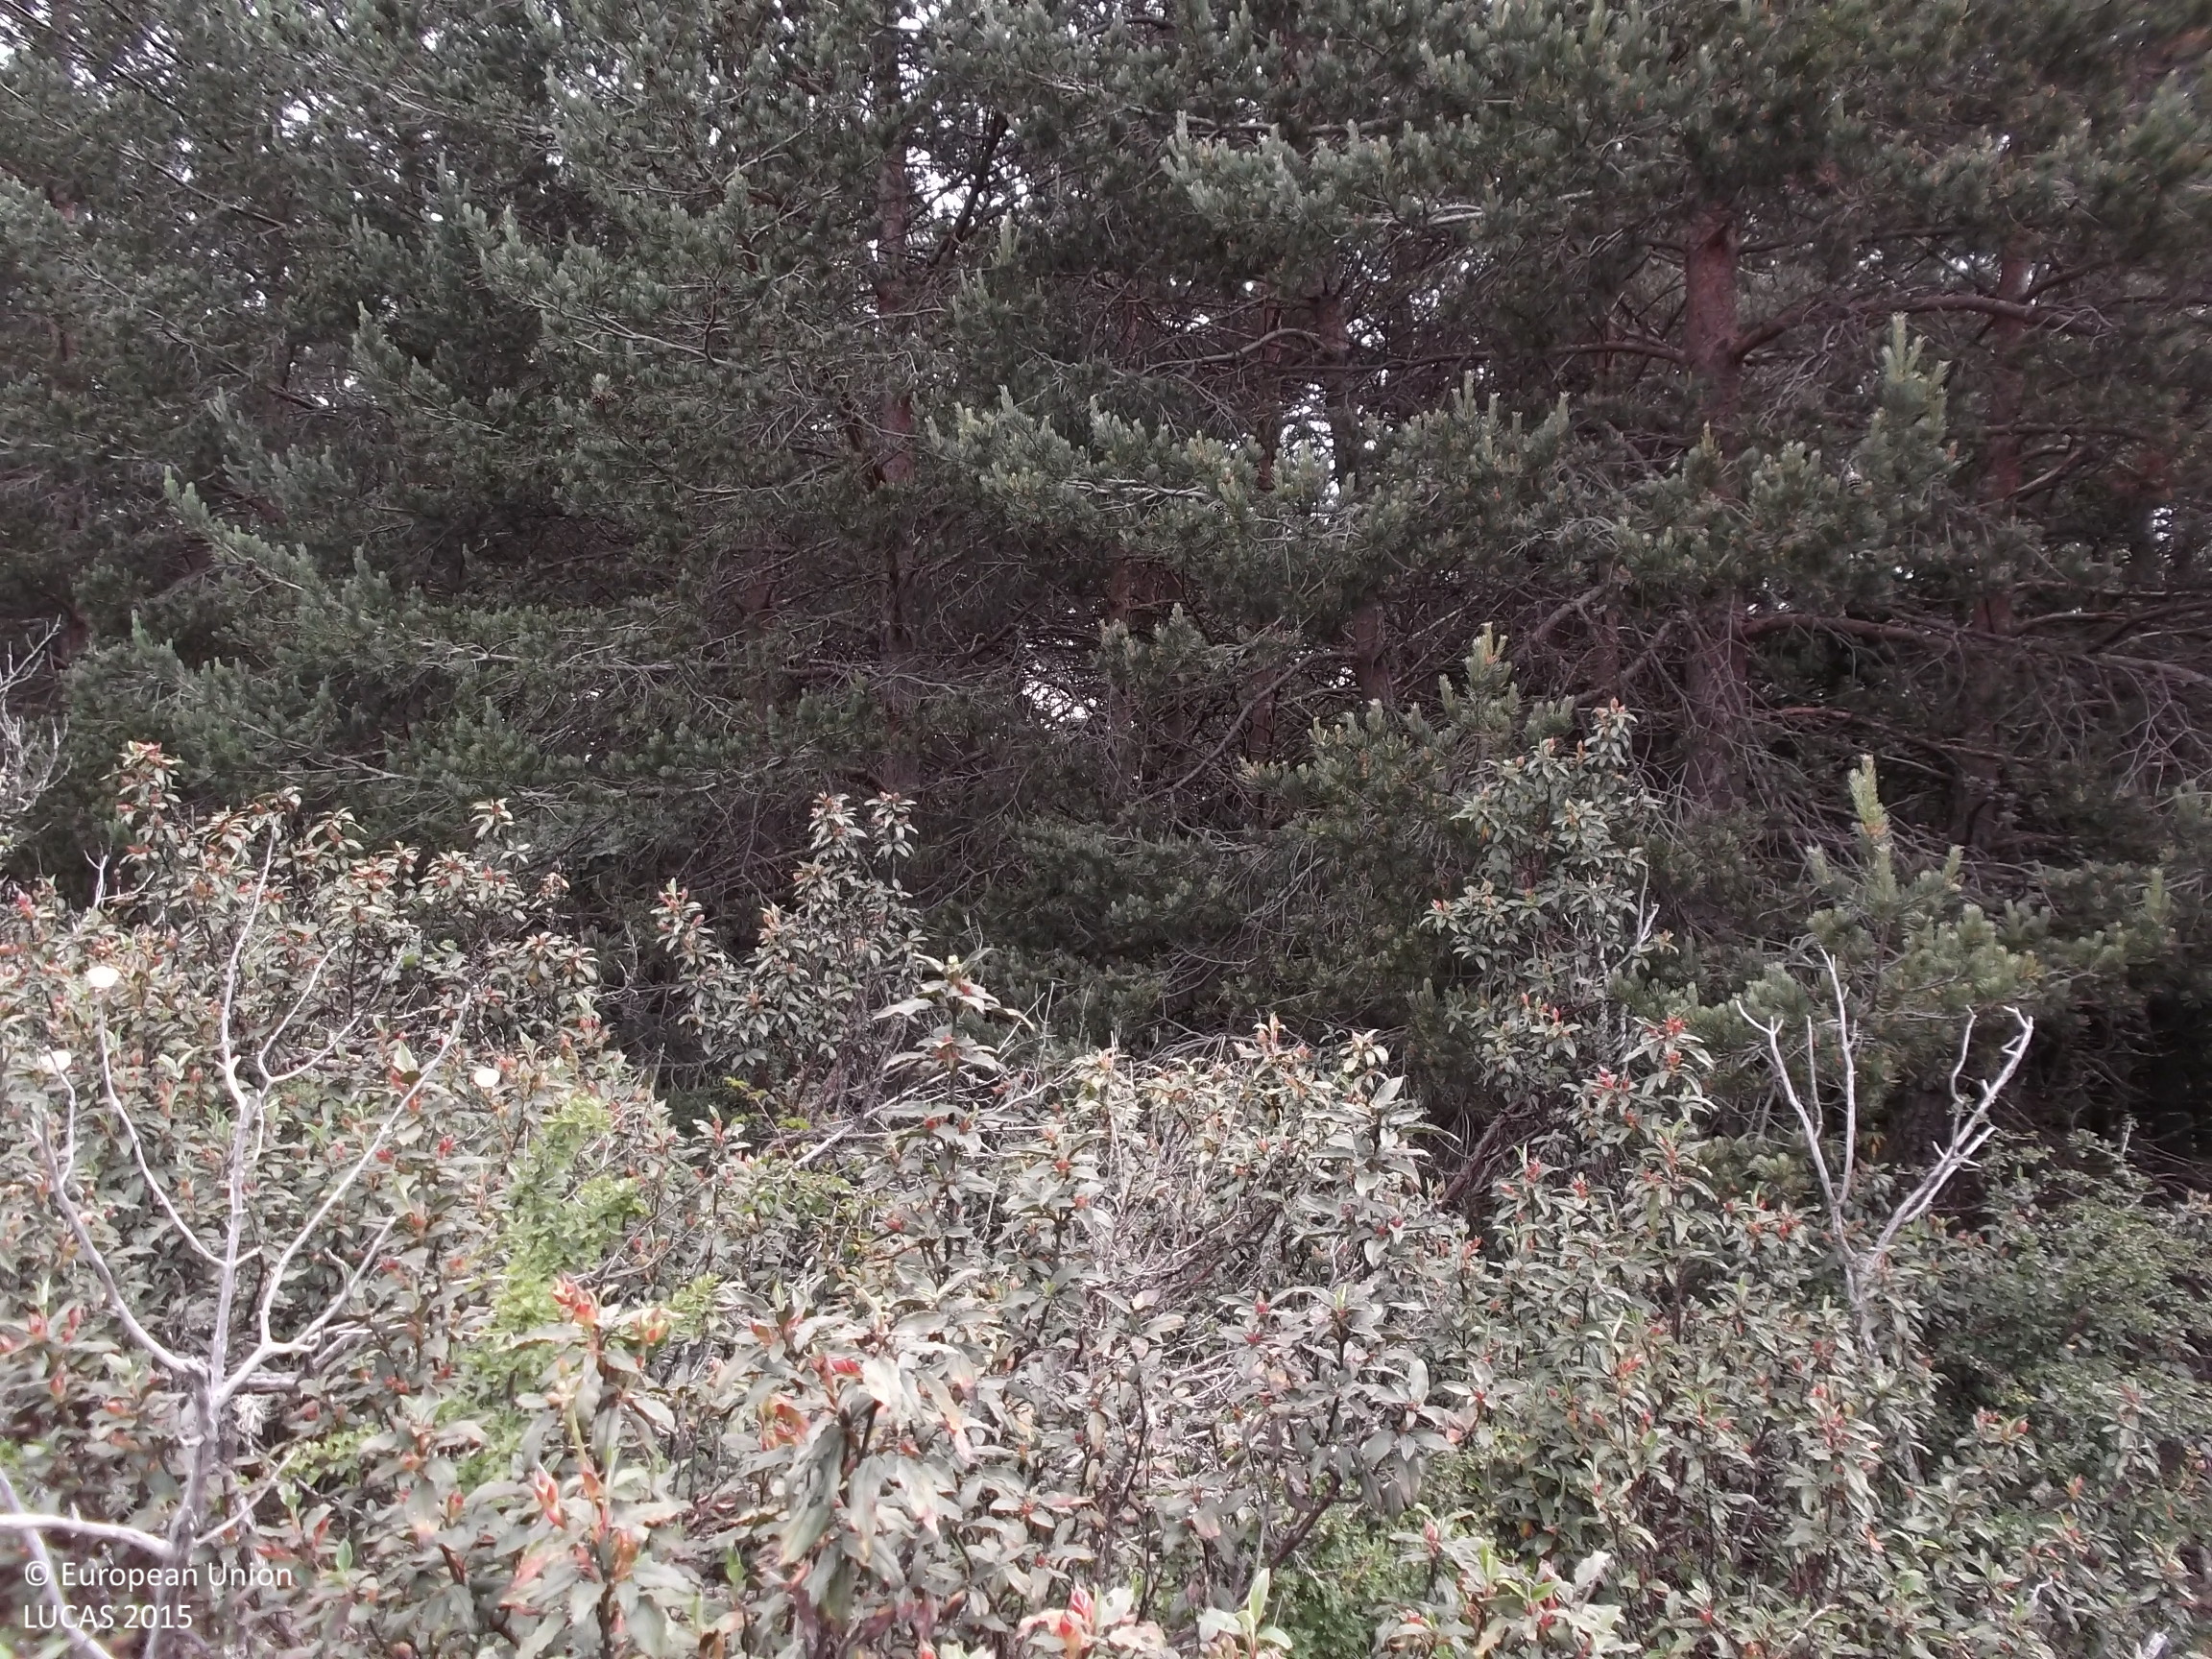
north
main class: Shrubland
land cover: Shrubland without tree cover
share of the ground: > 75 %
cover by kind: shrubs 80 %, herbaceous plants 15 %
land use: Agriculture (excluding fallow land and kitchen gardens)
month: June
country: ES
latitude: 42.2191
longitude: -2.3863
